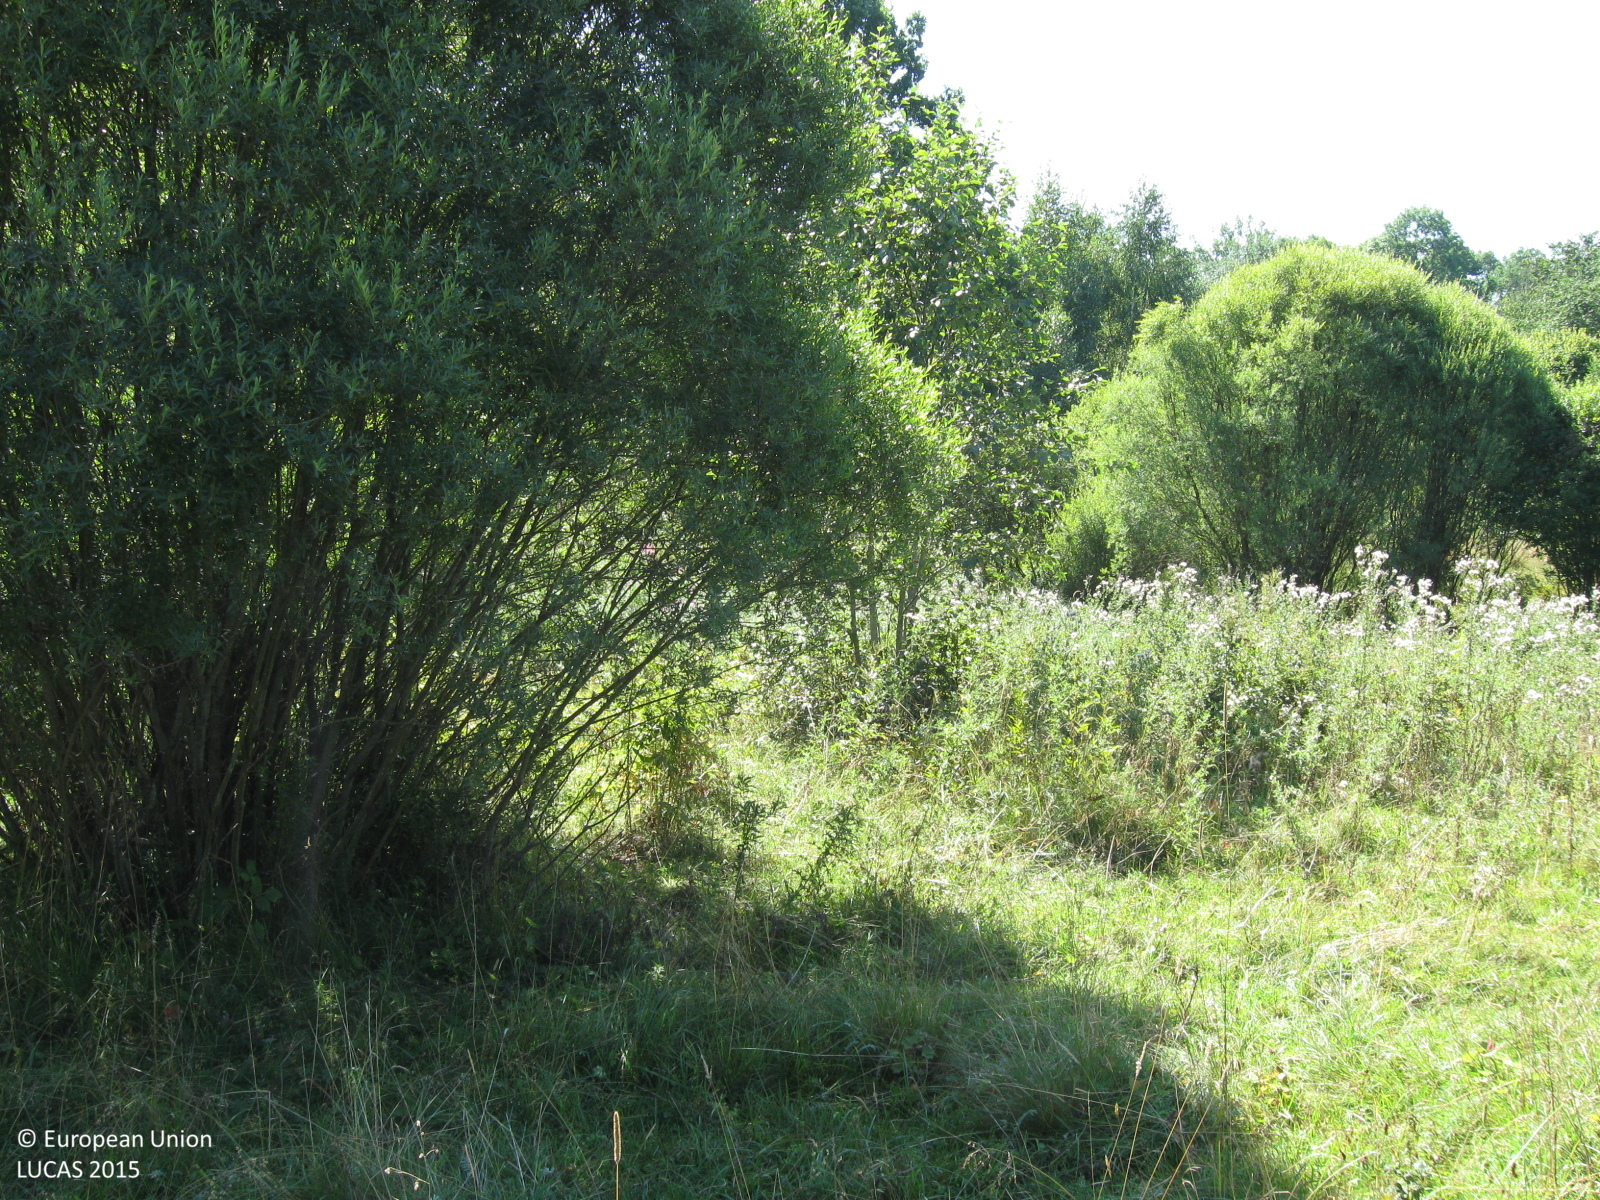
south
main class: Woodland
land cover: Broadleaved woodland
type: non-riverine alder, birch or aspen forest
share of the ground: 25 - 50 %
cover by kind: herbaceous plants 60 %, broadleaved forest trees 30 %, shrubs 10 %
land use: Forestry
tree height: < 5 m
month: August
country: LT
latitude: 55.3865
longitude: 22.5483
